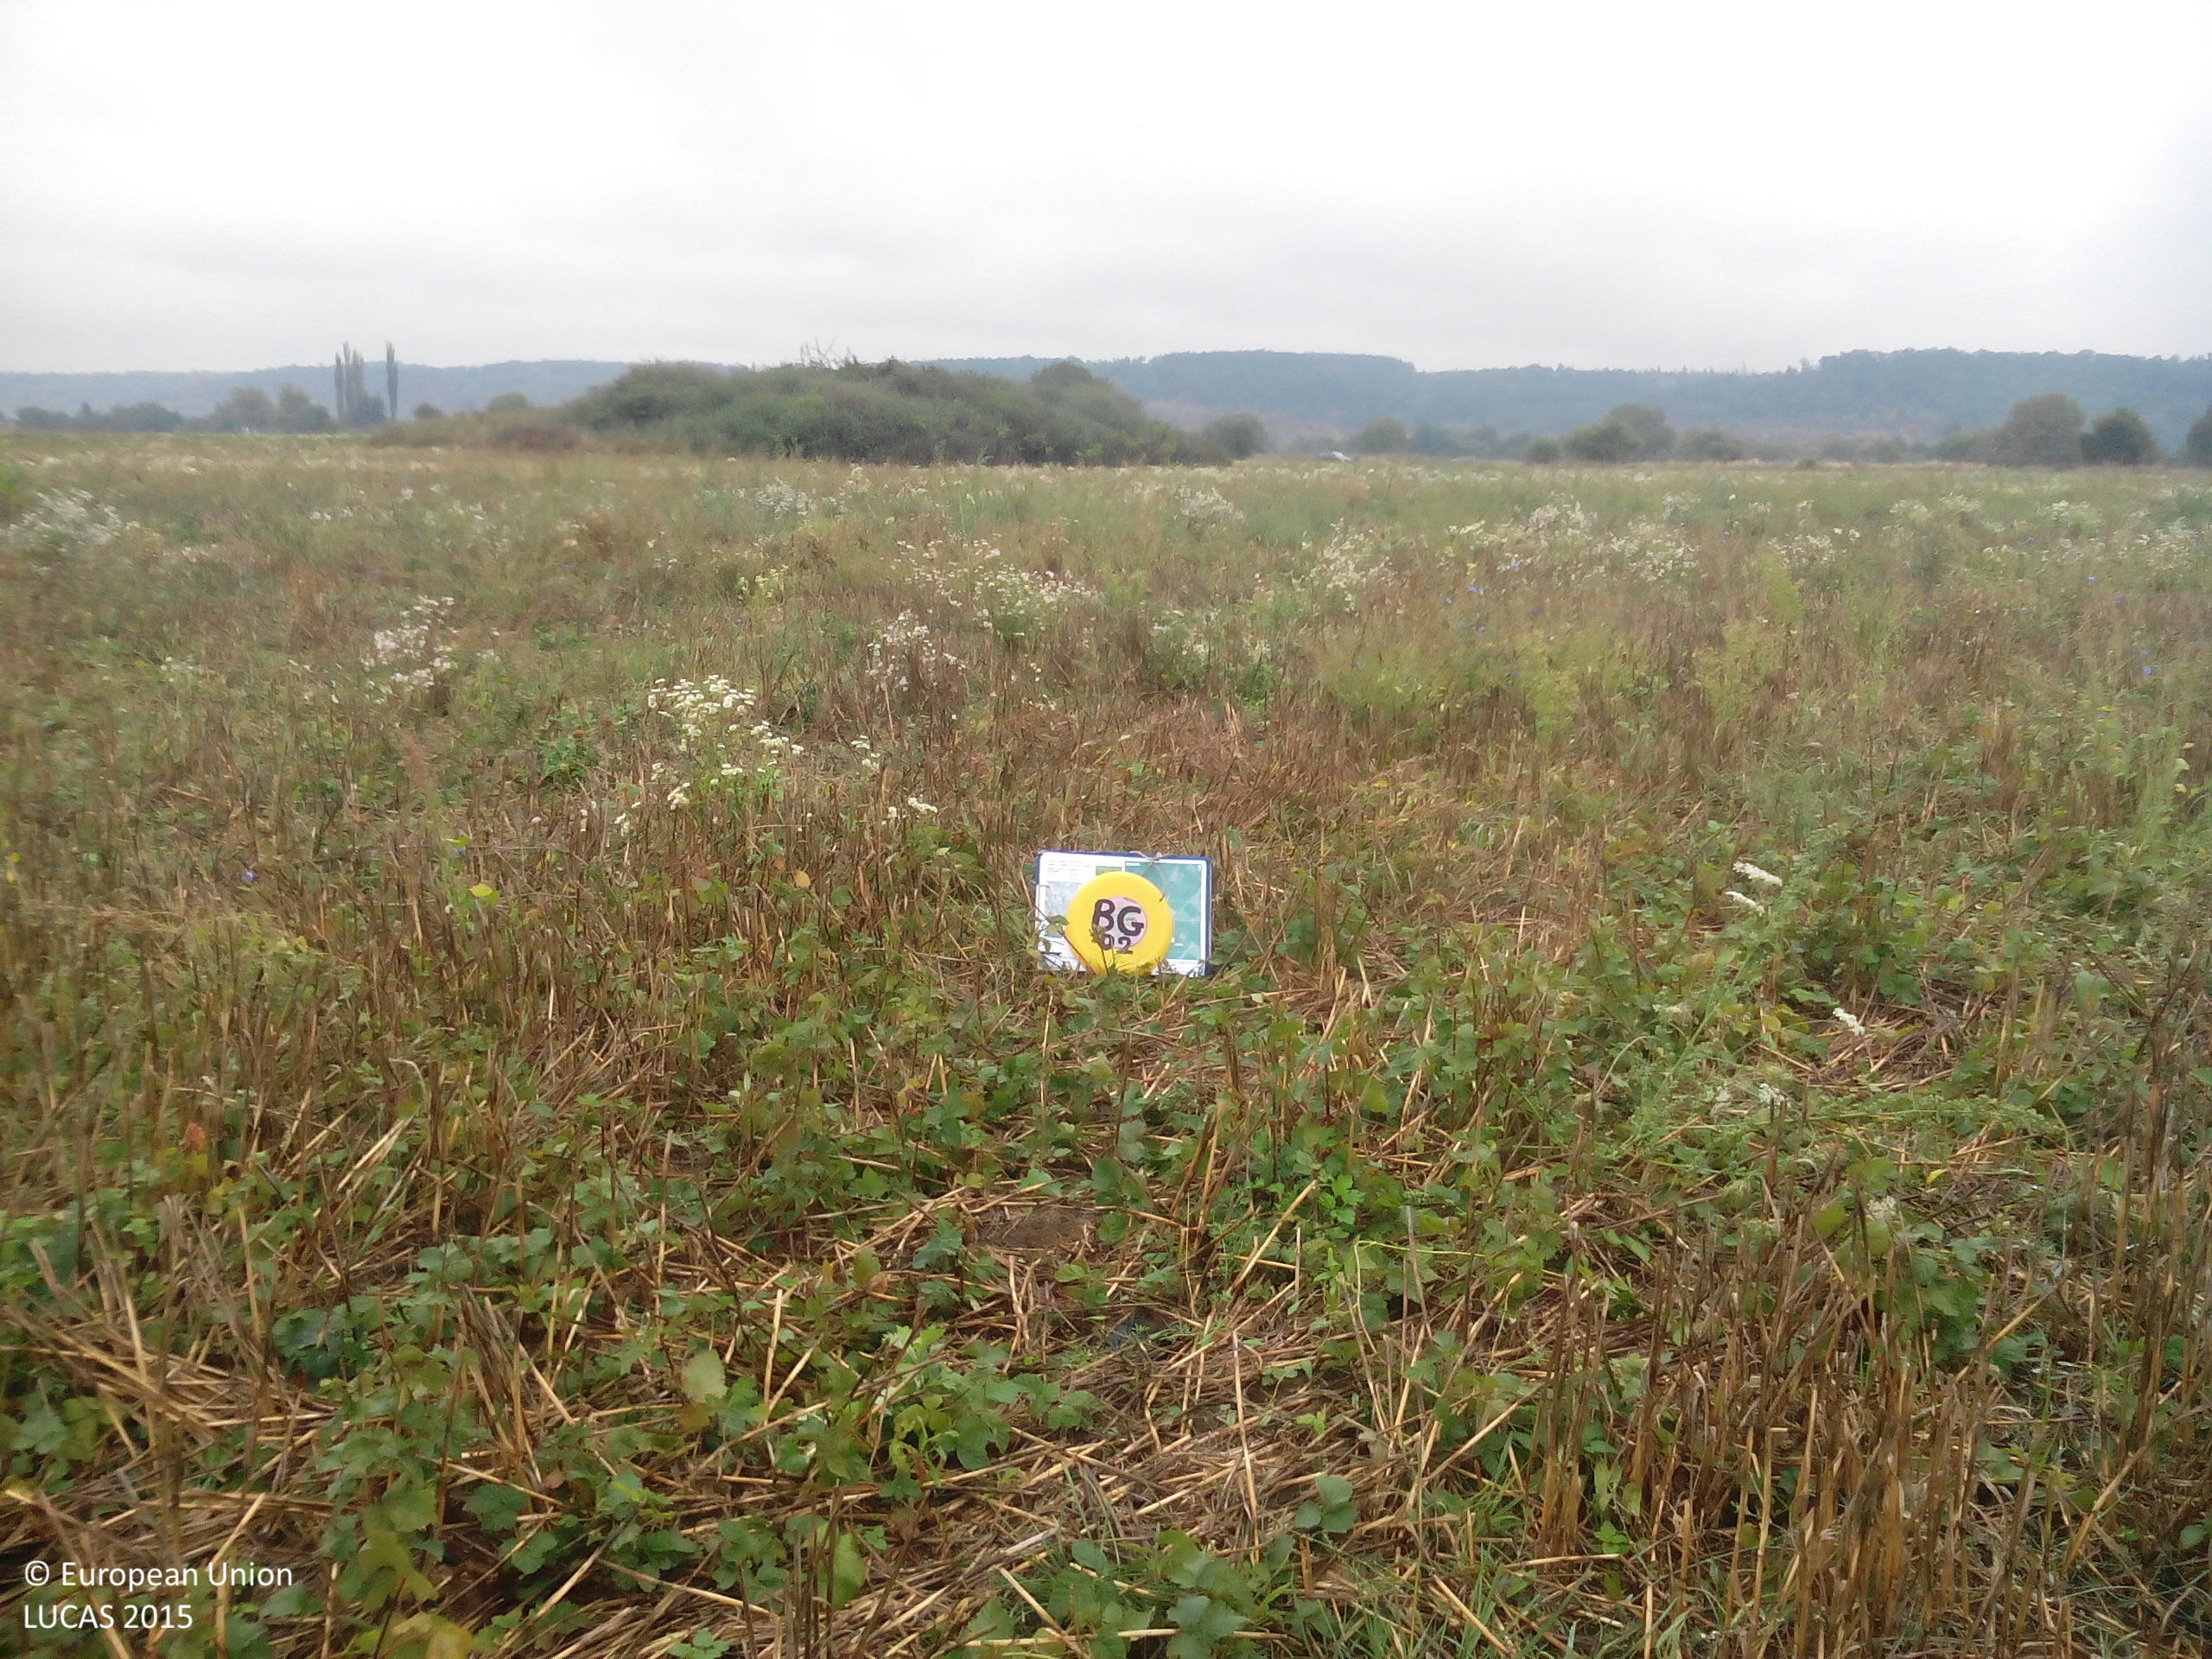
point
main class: Cropland
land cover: Common wheat
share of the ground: 10 - 25 %
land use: Agriculture (excluding fallow land and kitchen gardens)
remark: Harvested field
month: October
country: BG
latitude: 43.0846
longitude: 24.2653
